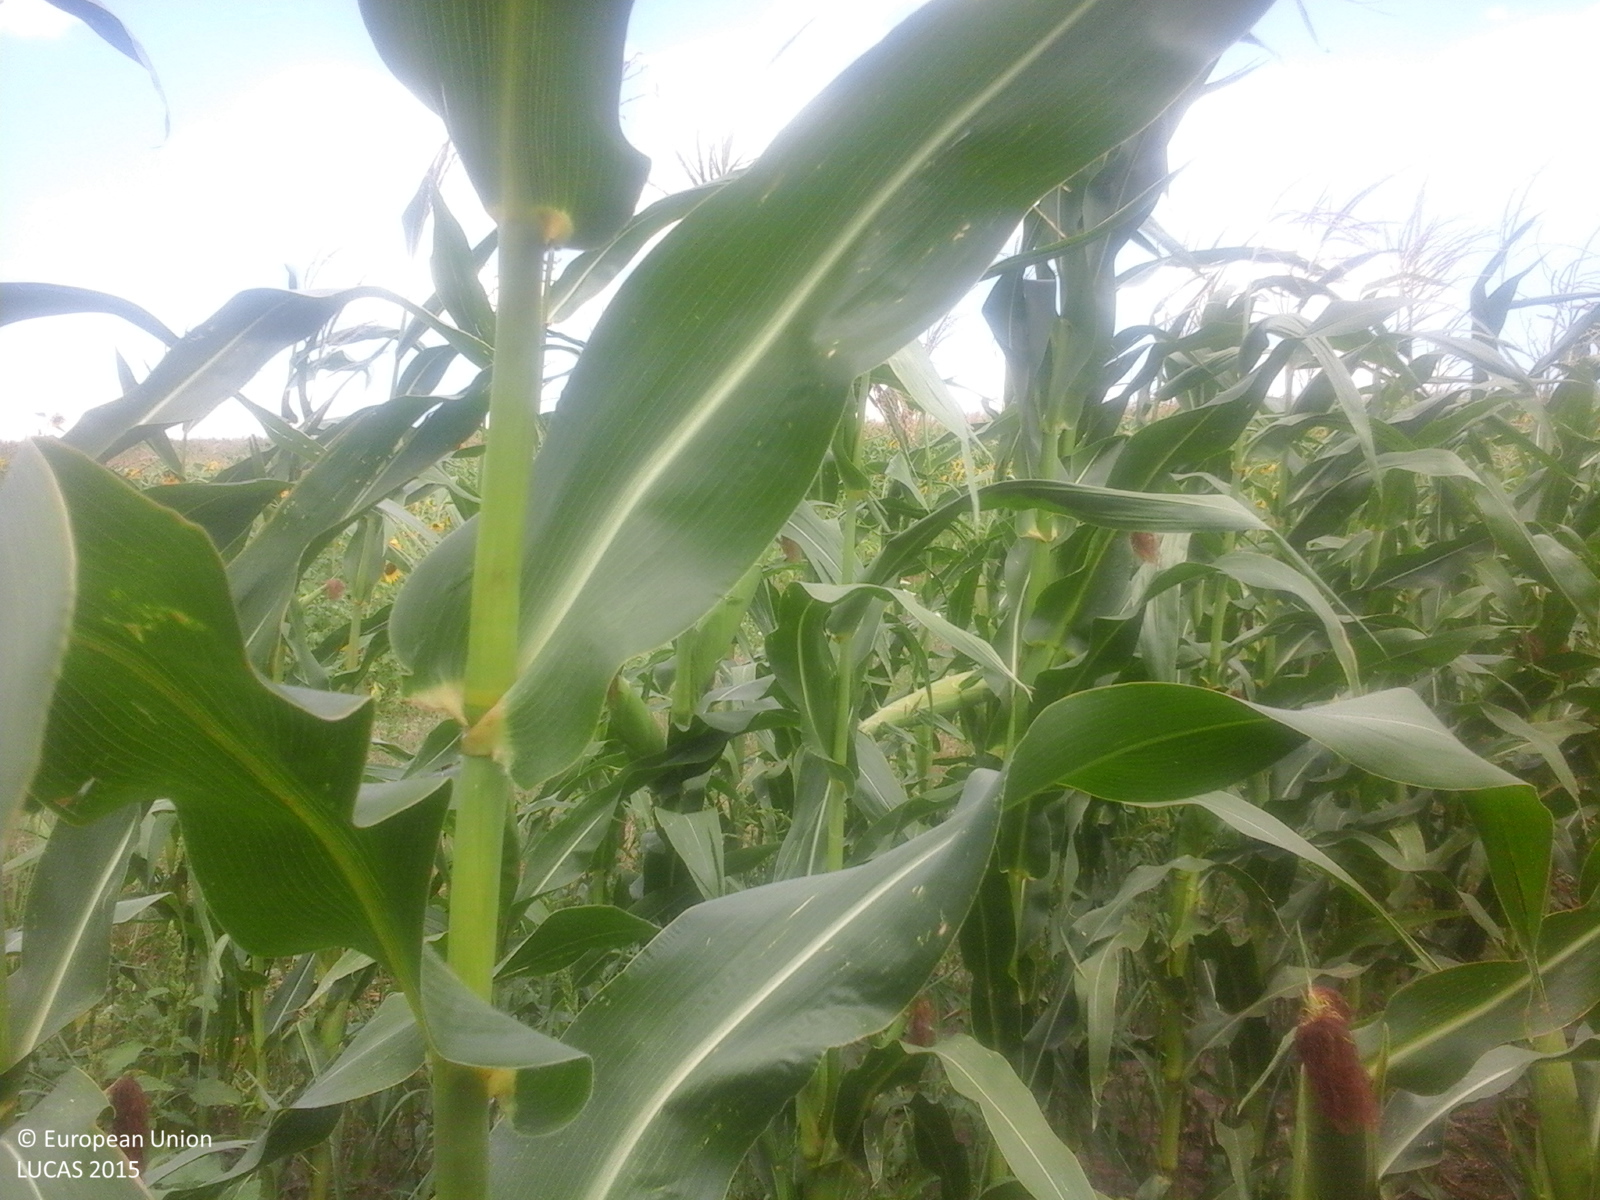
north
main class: Cropland
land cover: Maize
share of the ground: > 75 %
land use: Agriculture (excluding fallow land and kitchen gardens)
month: July
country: RO
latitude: 46.5227
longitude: 27.9985
